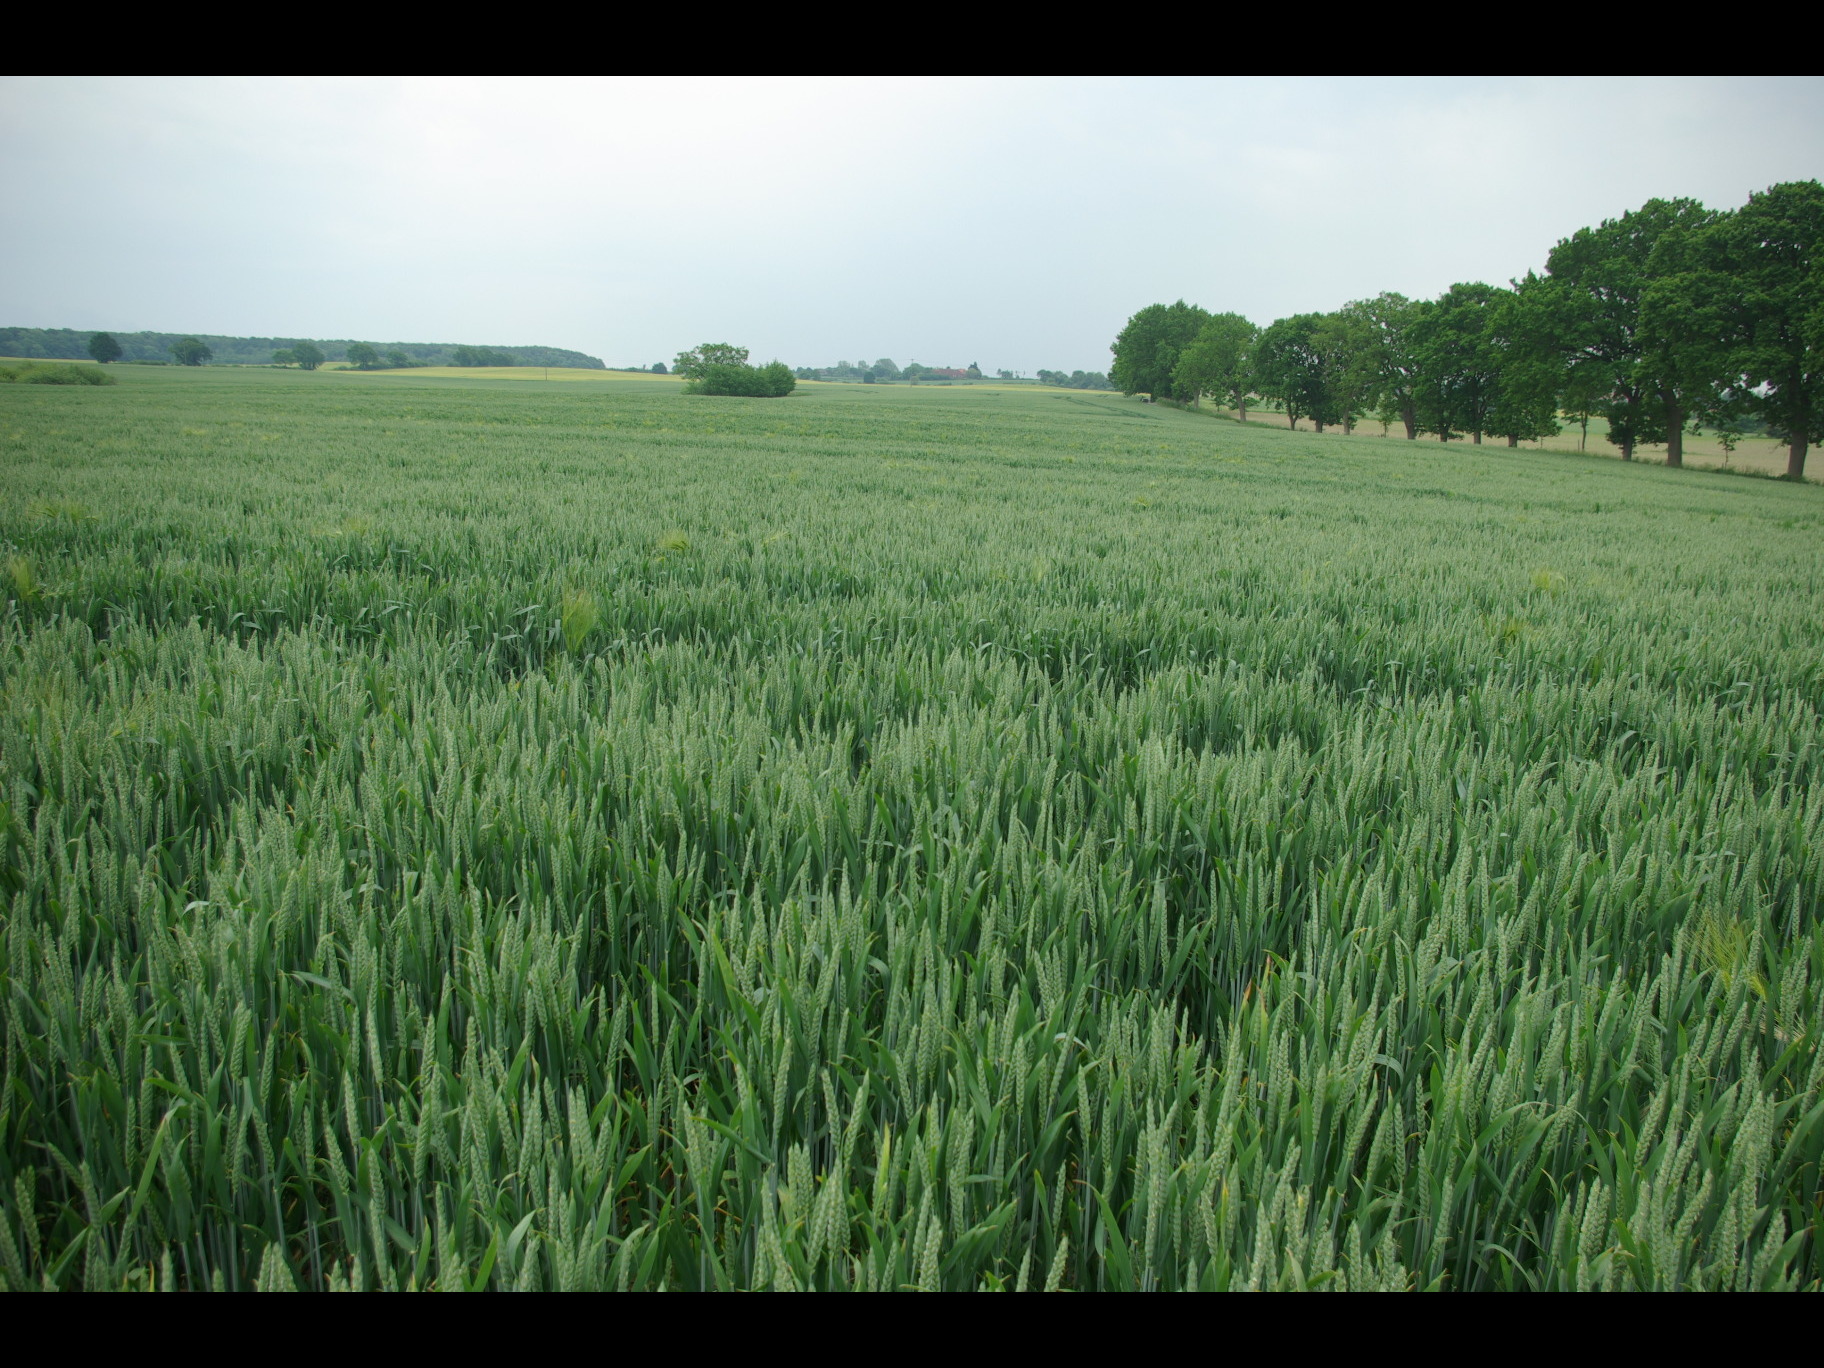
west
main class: Cropland
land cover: Common wheat
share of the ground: > 75 %
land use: Agriculture (excluding fallow land and kitchen gardens)
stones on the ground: 10 - 25 %
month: June
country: DE
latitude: 54.4443
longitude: 9.9538
